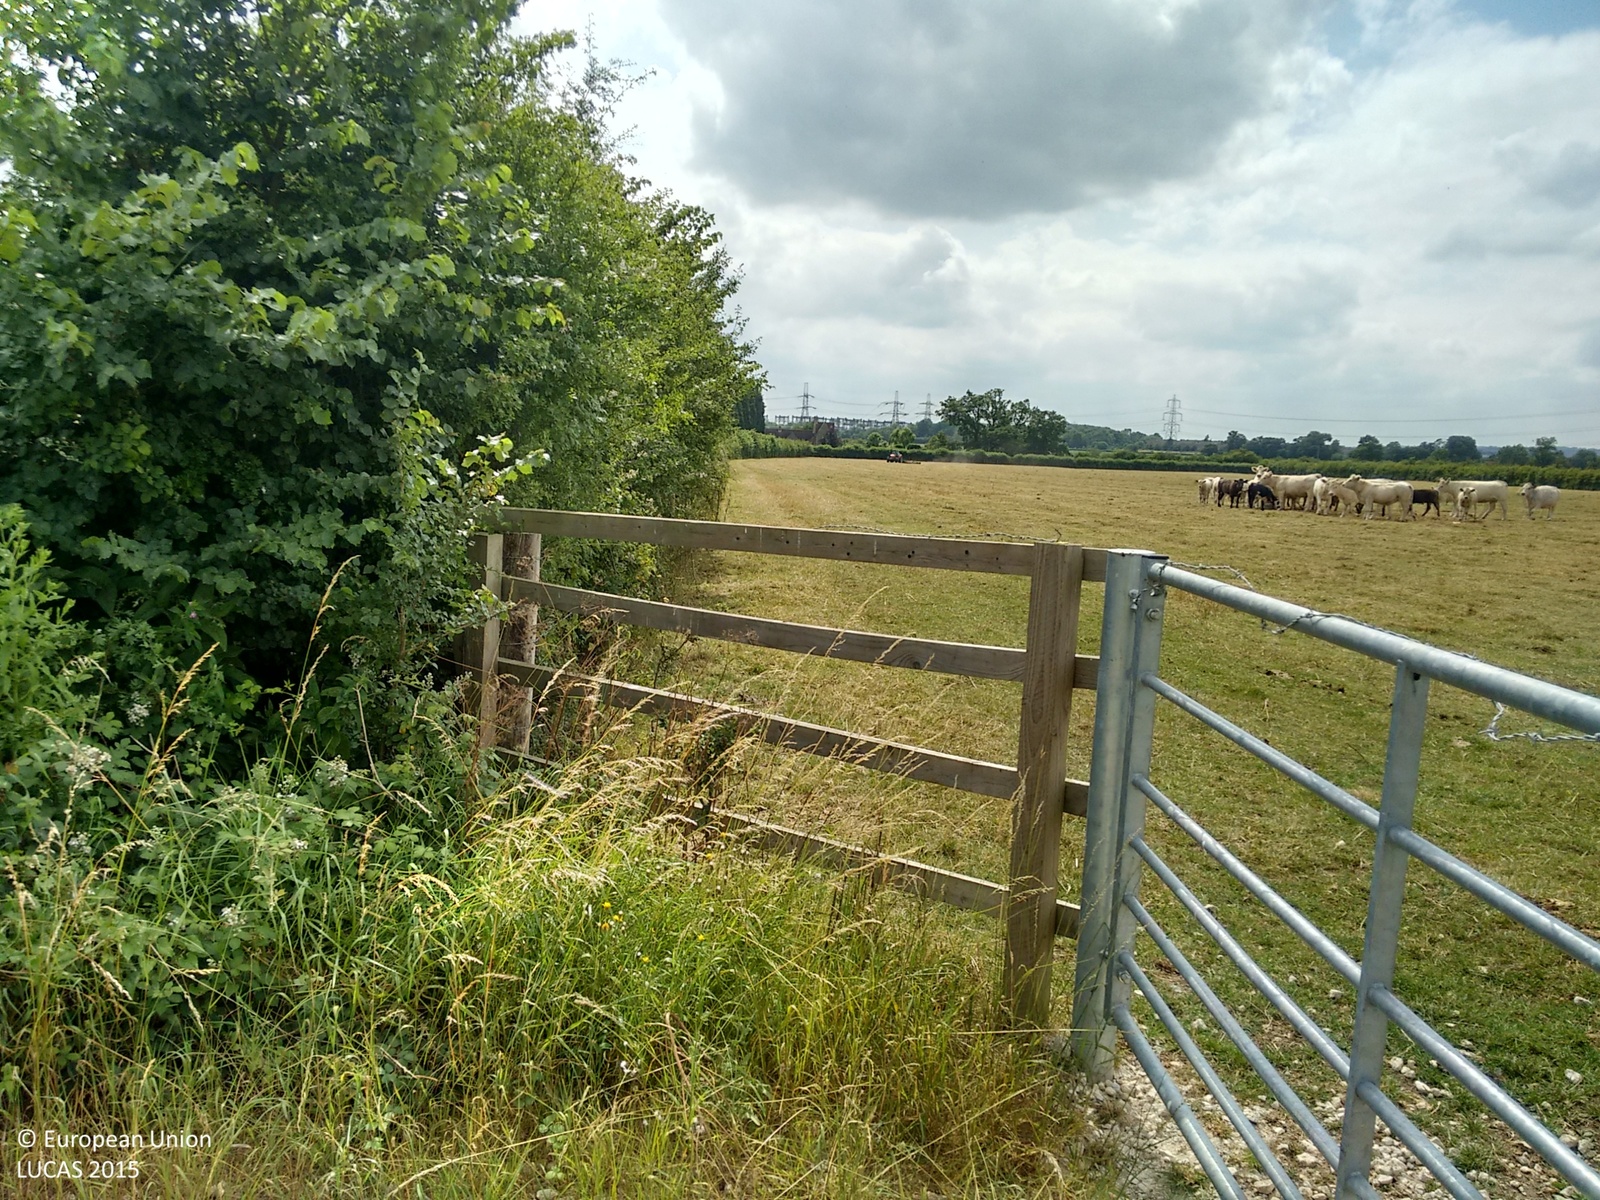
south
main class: Grassland
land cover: Grassland without tree/shrub cover
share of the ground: > 75 %
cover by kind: herbaceous plants 100 %
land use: Agriculture (excluding fallow land and kitchen gardens)
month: July
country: GB
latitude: 51.7205
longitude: -1.1786
